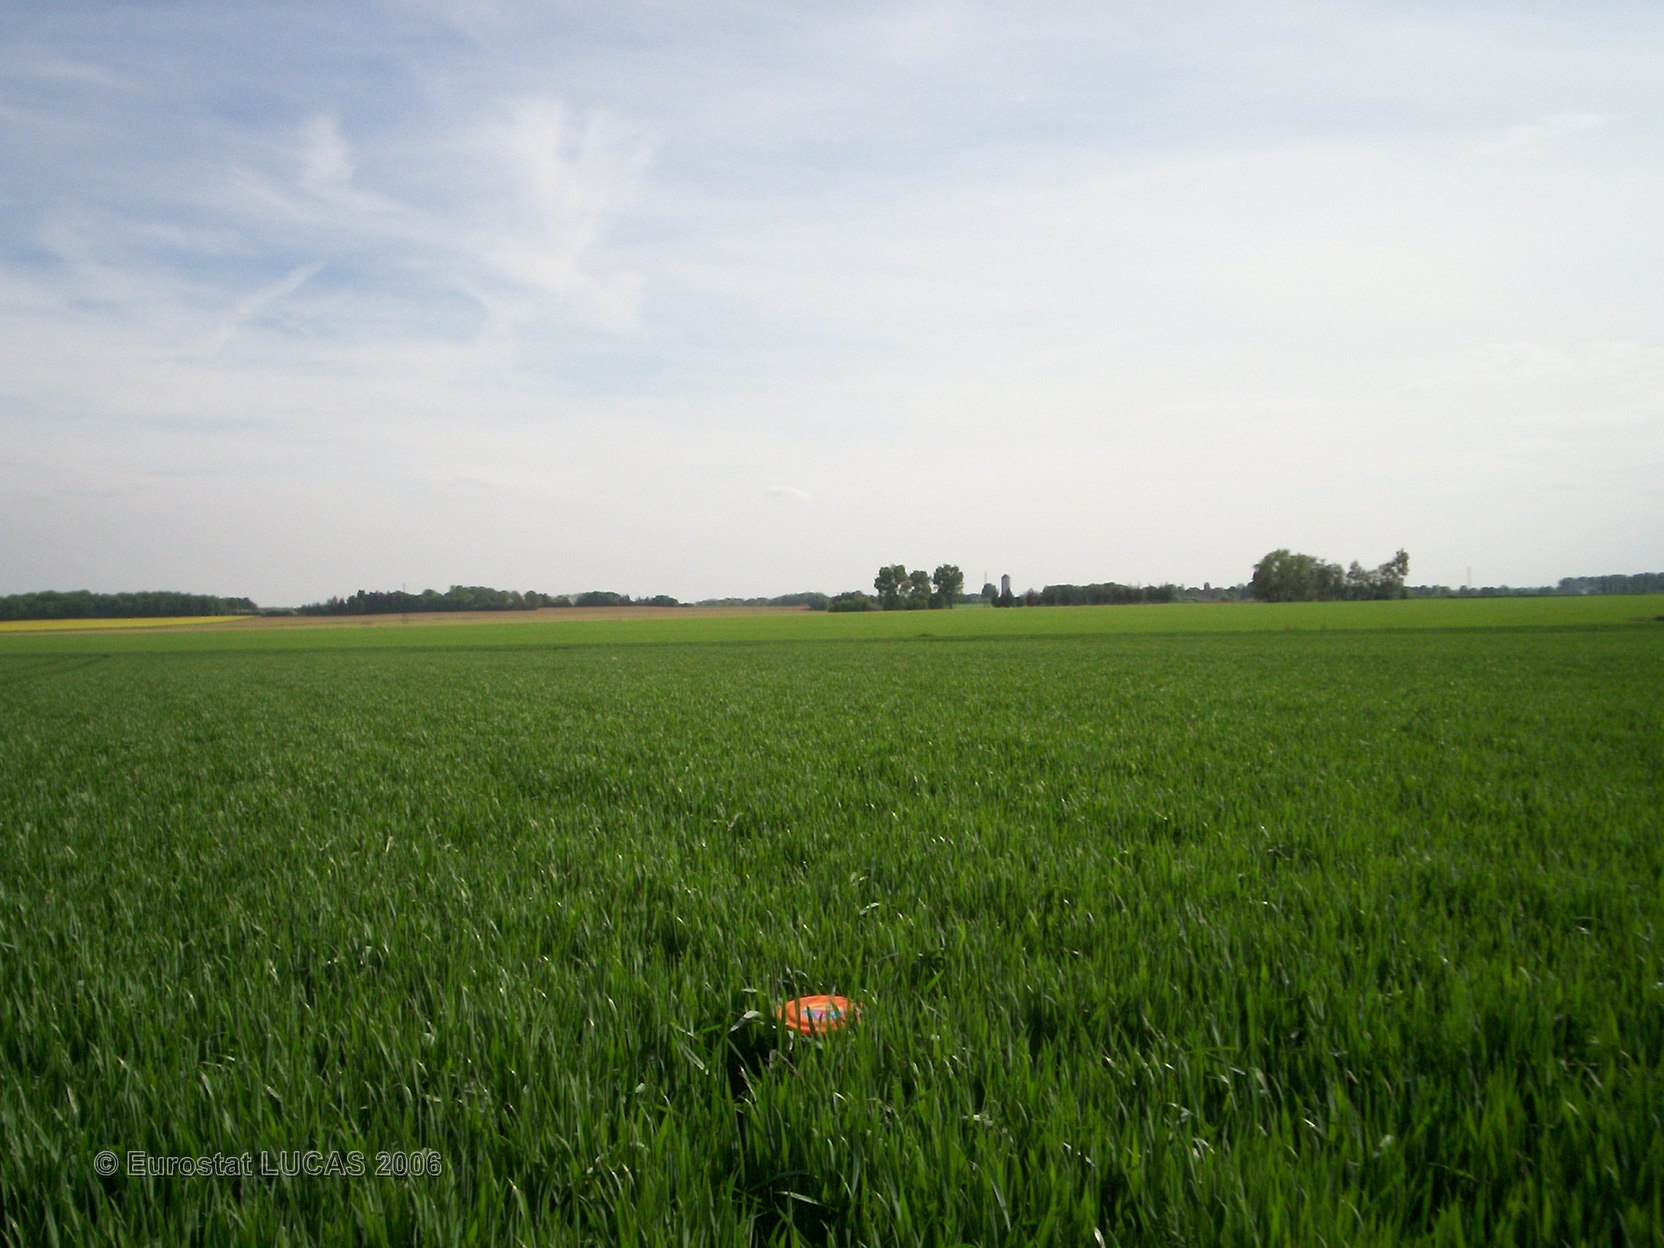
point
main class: Cropland
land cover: Common wheat
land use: Agriculture (excluding fallow land and kitchen gardens)
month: May
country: FR
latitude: 48.5888
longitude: 2.8735
